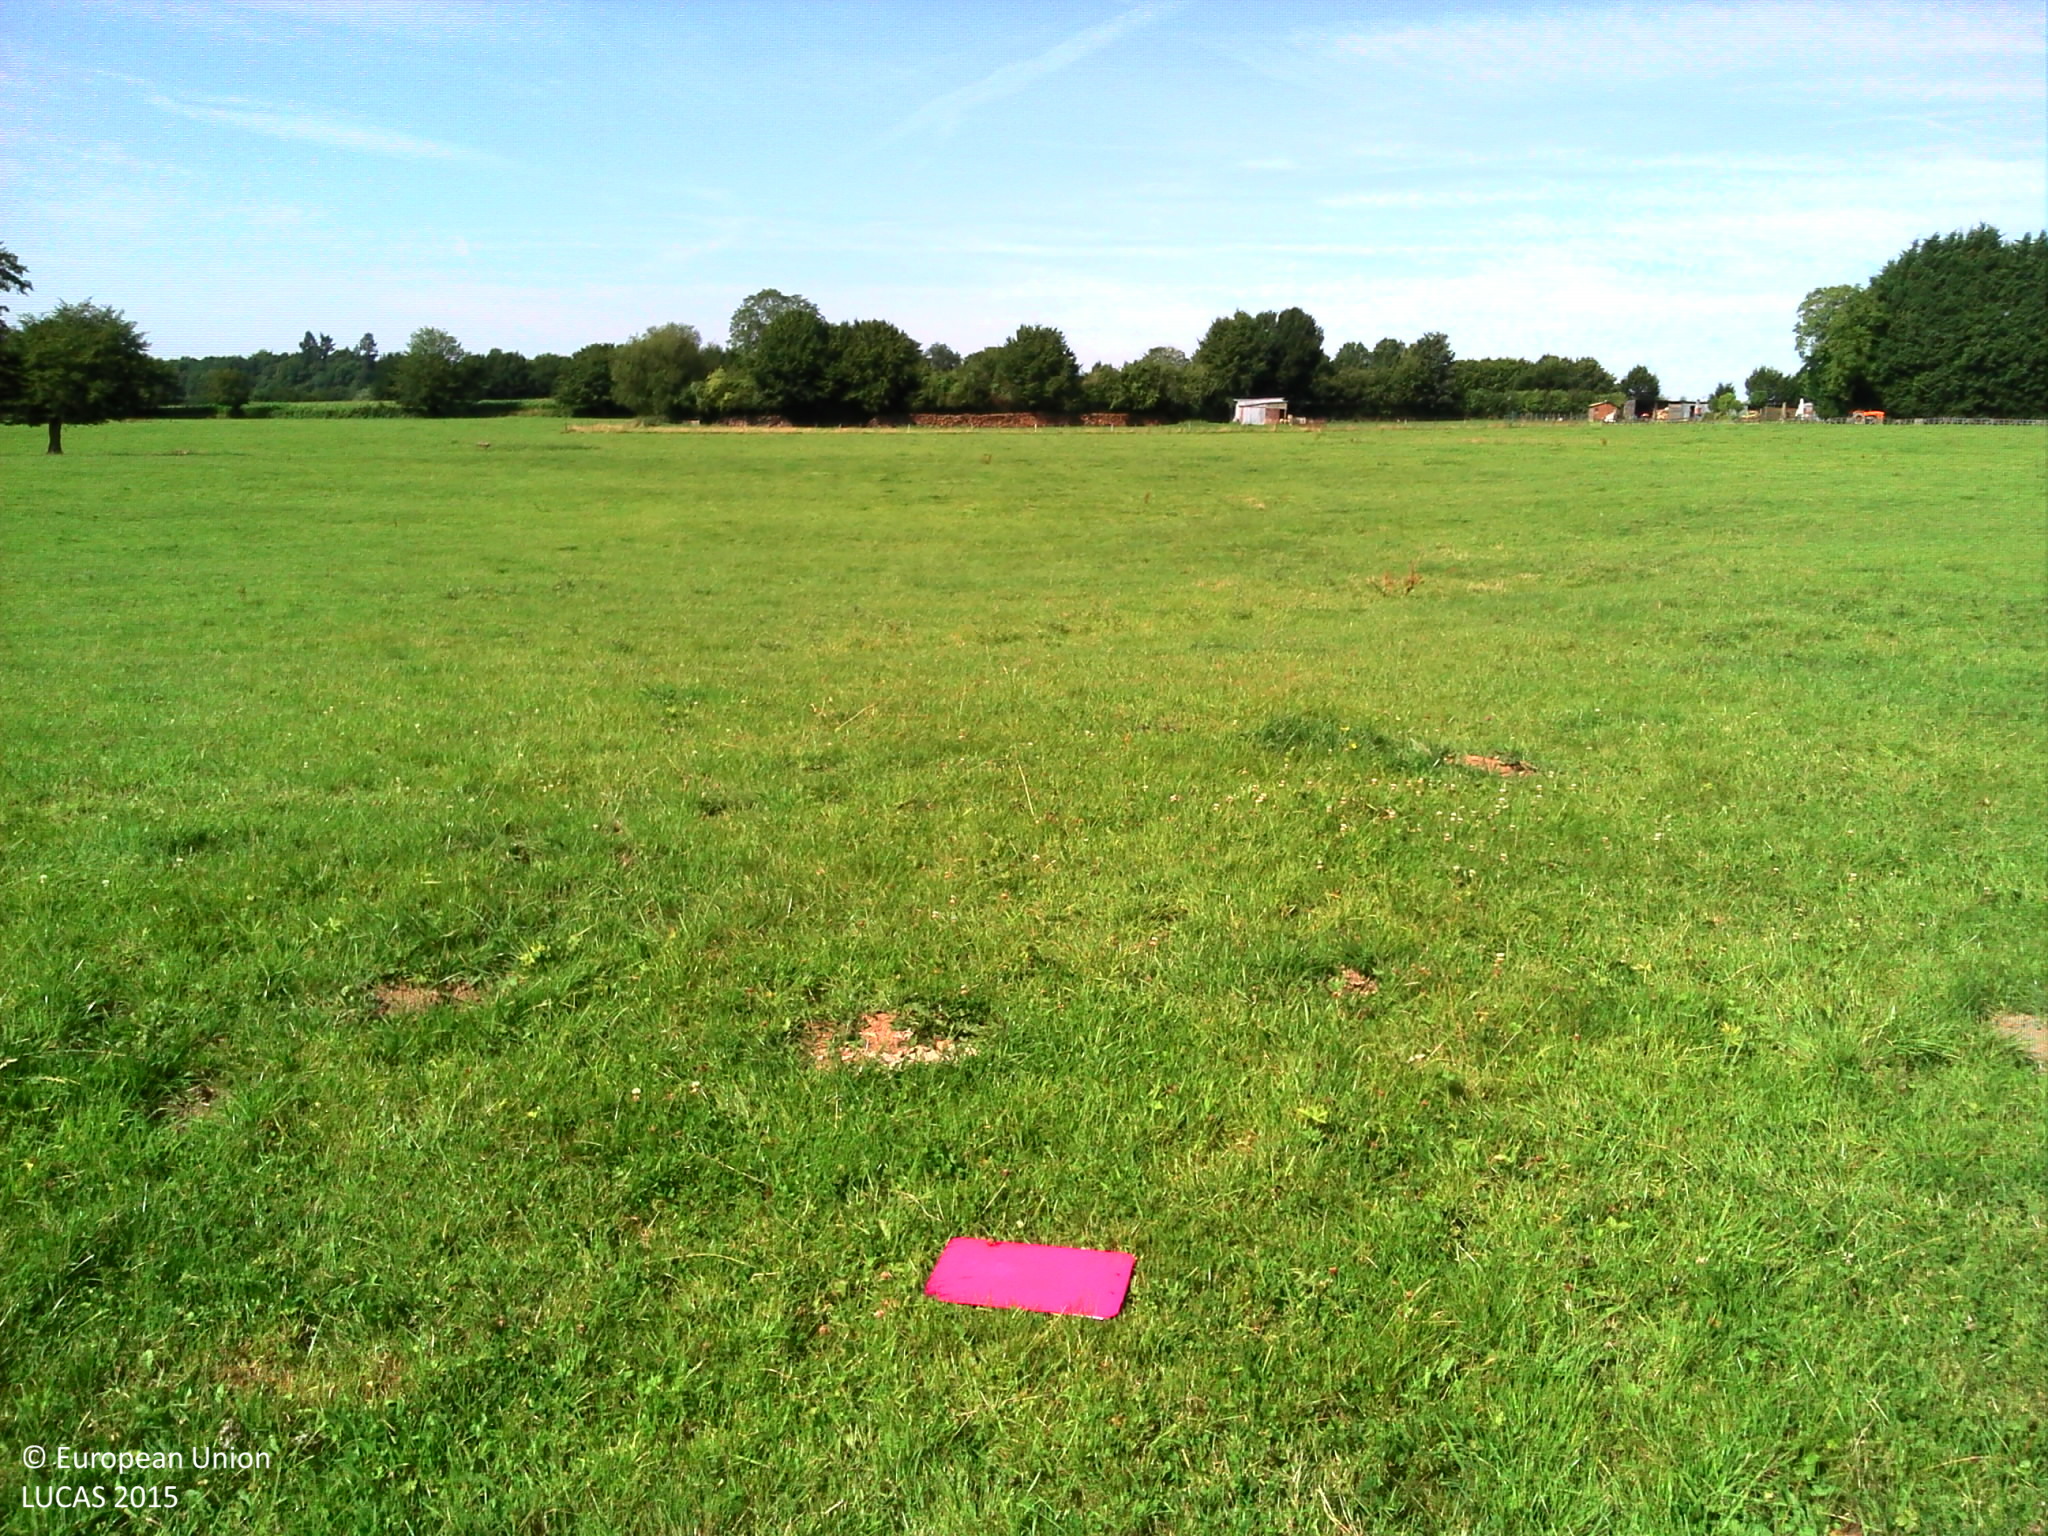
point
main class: Grassland
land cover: Grassland without tree/shrub cover
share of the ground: > 75 %
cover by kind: herbaceous plants 95 %, lichens and mosses 5 %
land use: Agriculture (excluding fallow land and kitchen gardens)
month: August
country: FR
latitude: 50.0818
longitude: 4.0272
